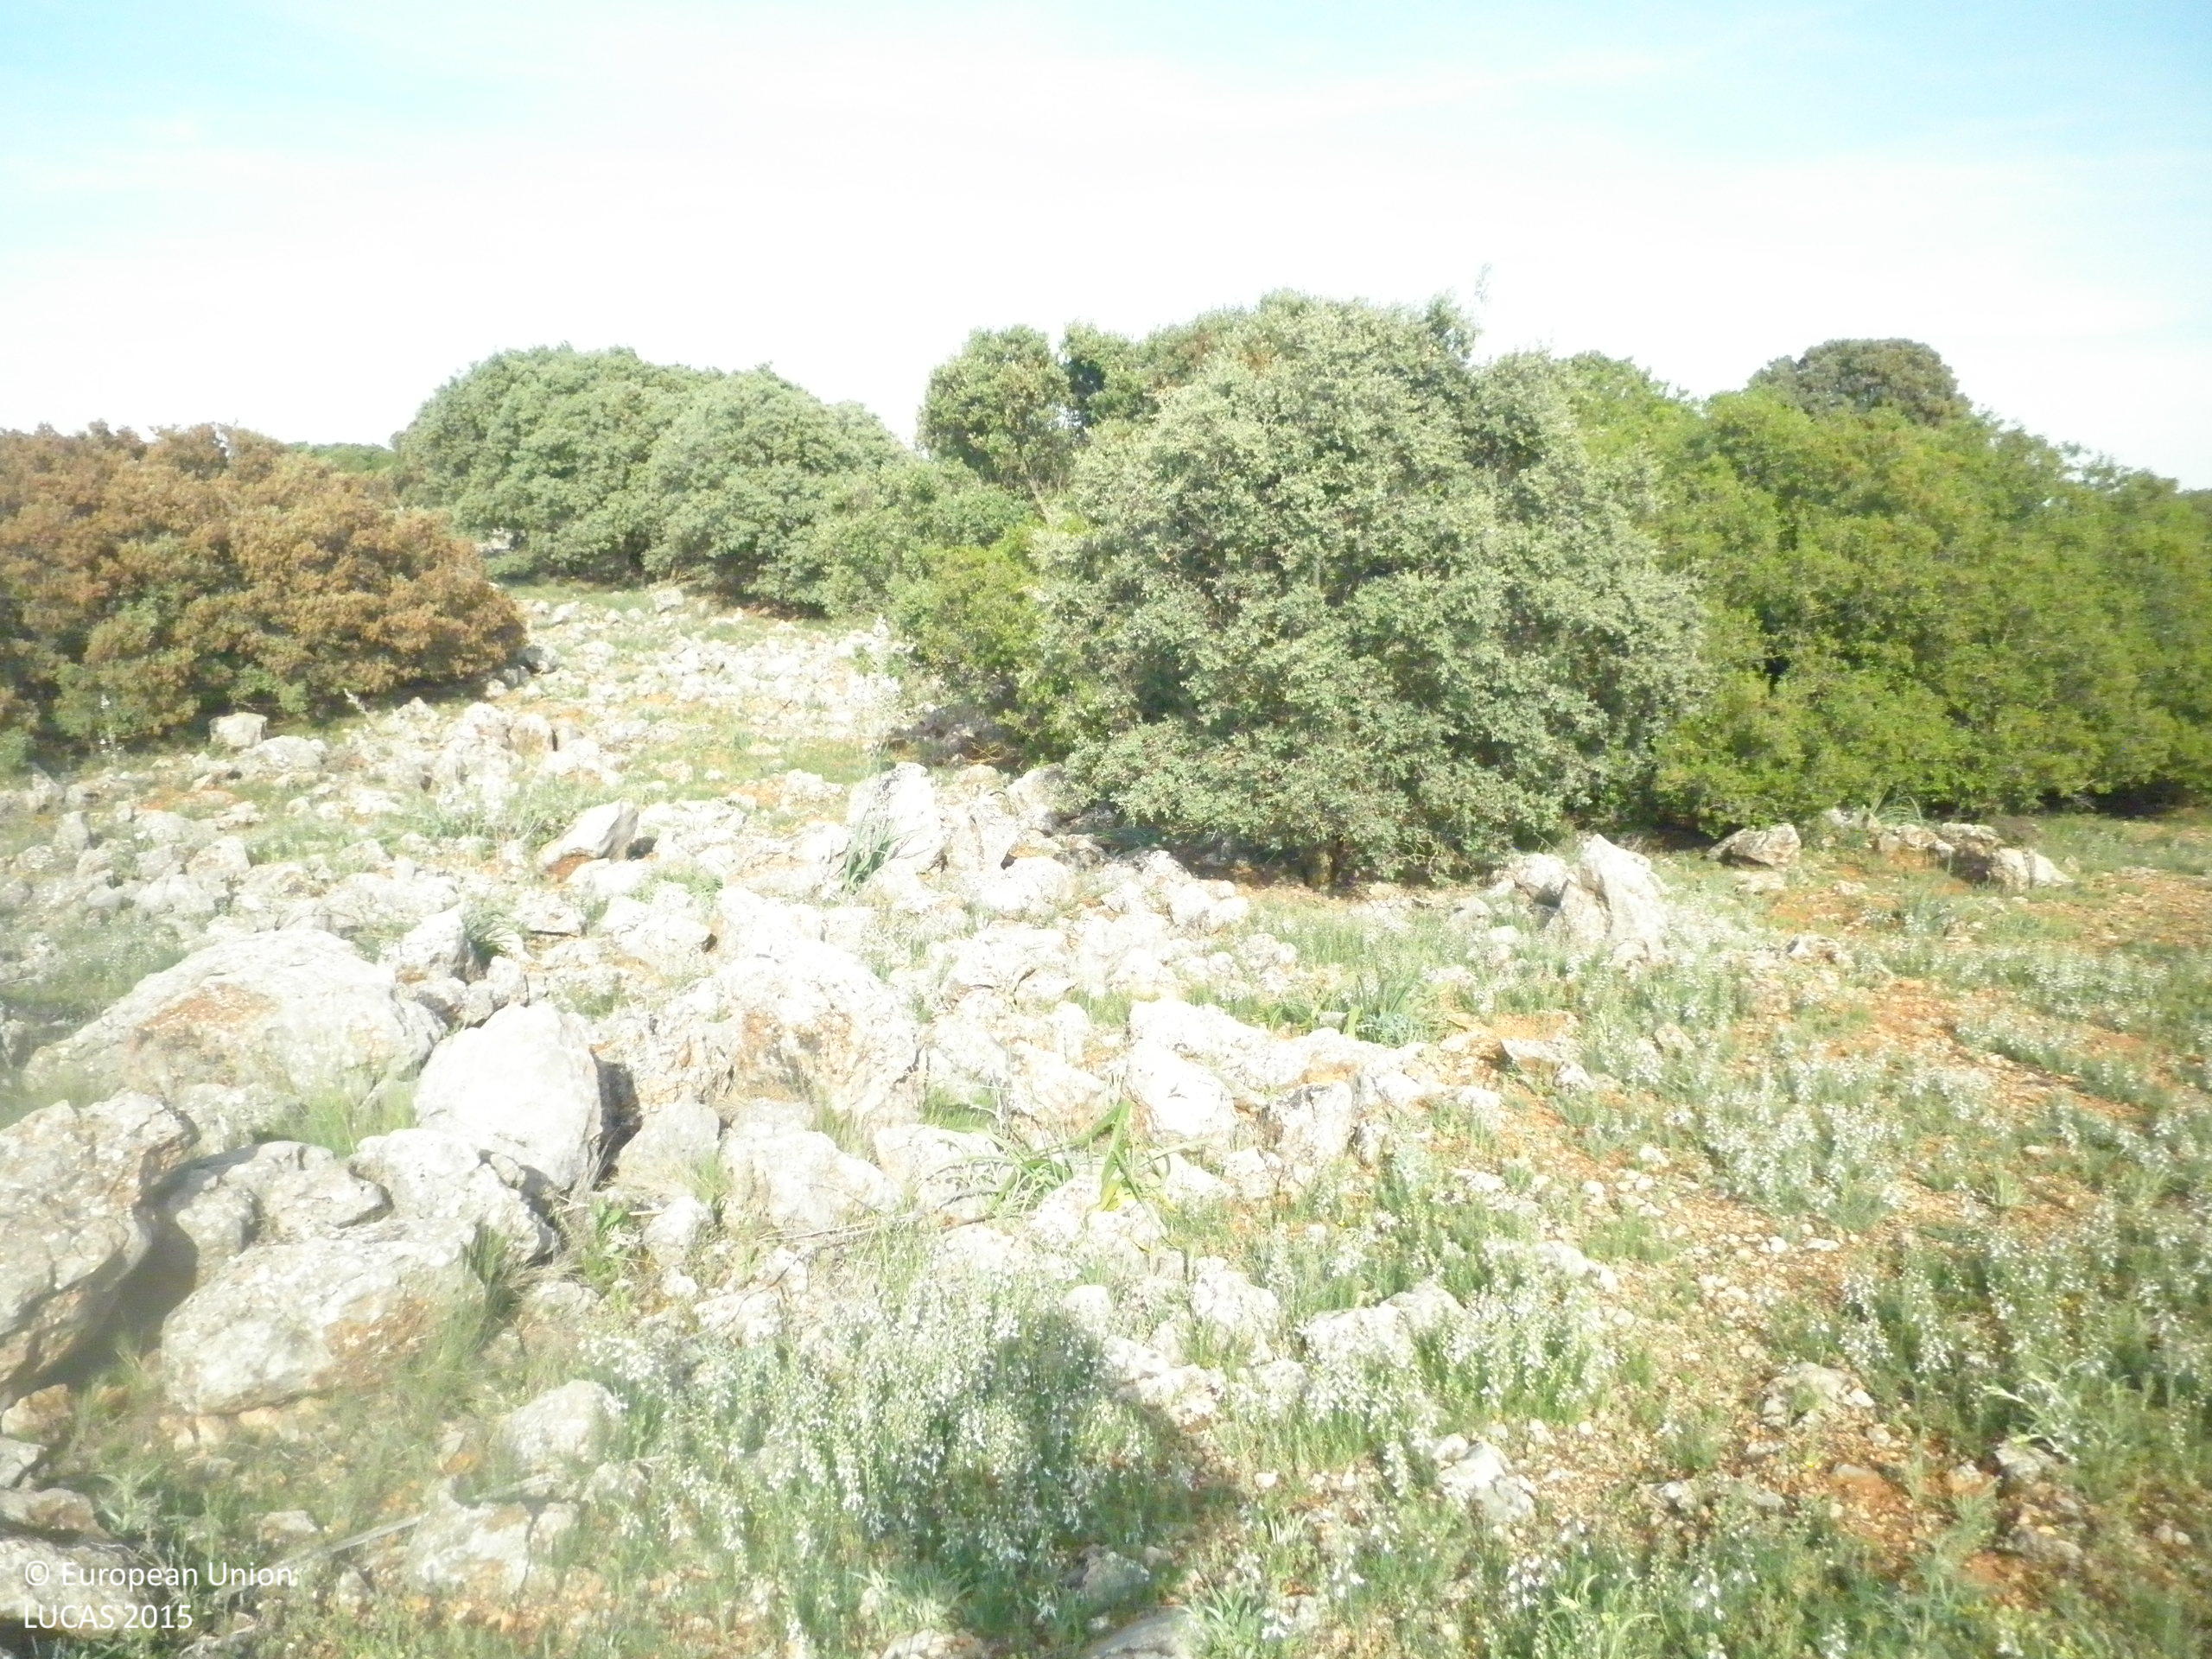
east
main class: Grassland
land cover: Grassland without tree/shrub cover
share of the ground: 25 - 50 %
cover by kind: herbaceous plants 45 %, consolidated bare surface 25 %, unconsolidated bare surface 25 %, shrubs 5 %
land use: Semi-natural and natural areas not in use
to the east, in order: Grassland without tree/shrub cover; Dry stone walls; Broadleaved woodland; Tracks; Broadleaved woodland; Fences; Other bare soil
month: May
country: ES
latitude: 39.6268
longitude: -2.7968
